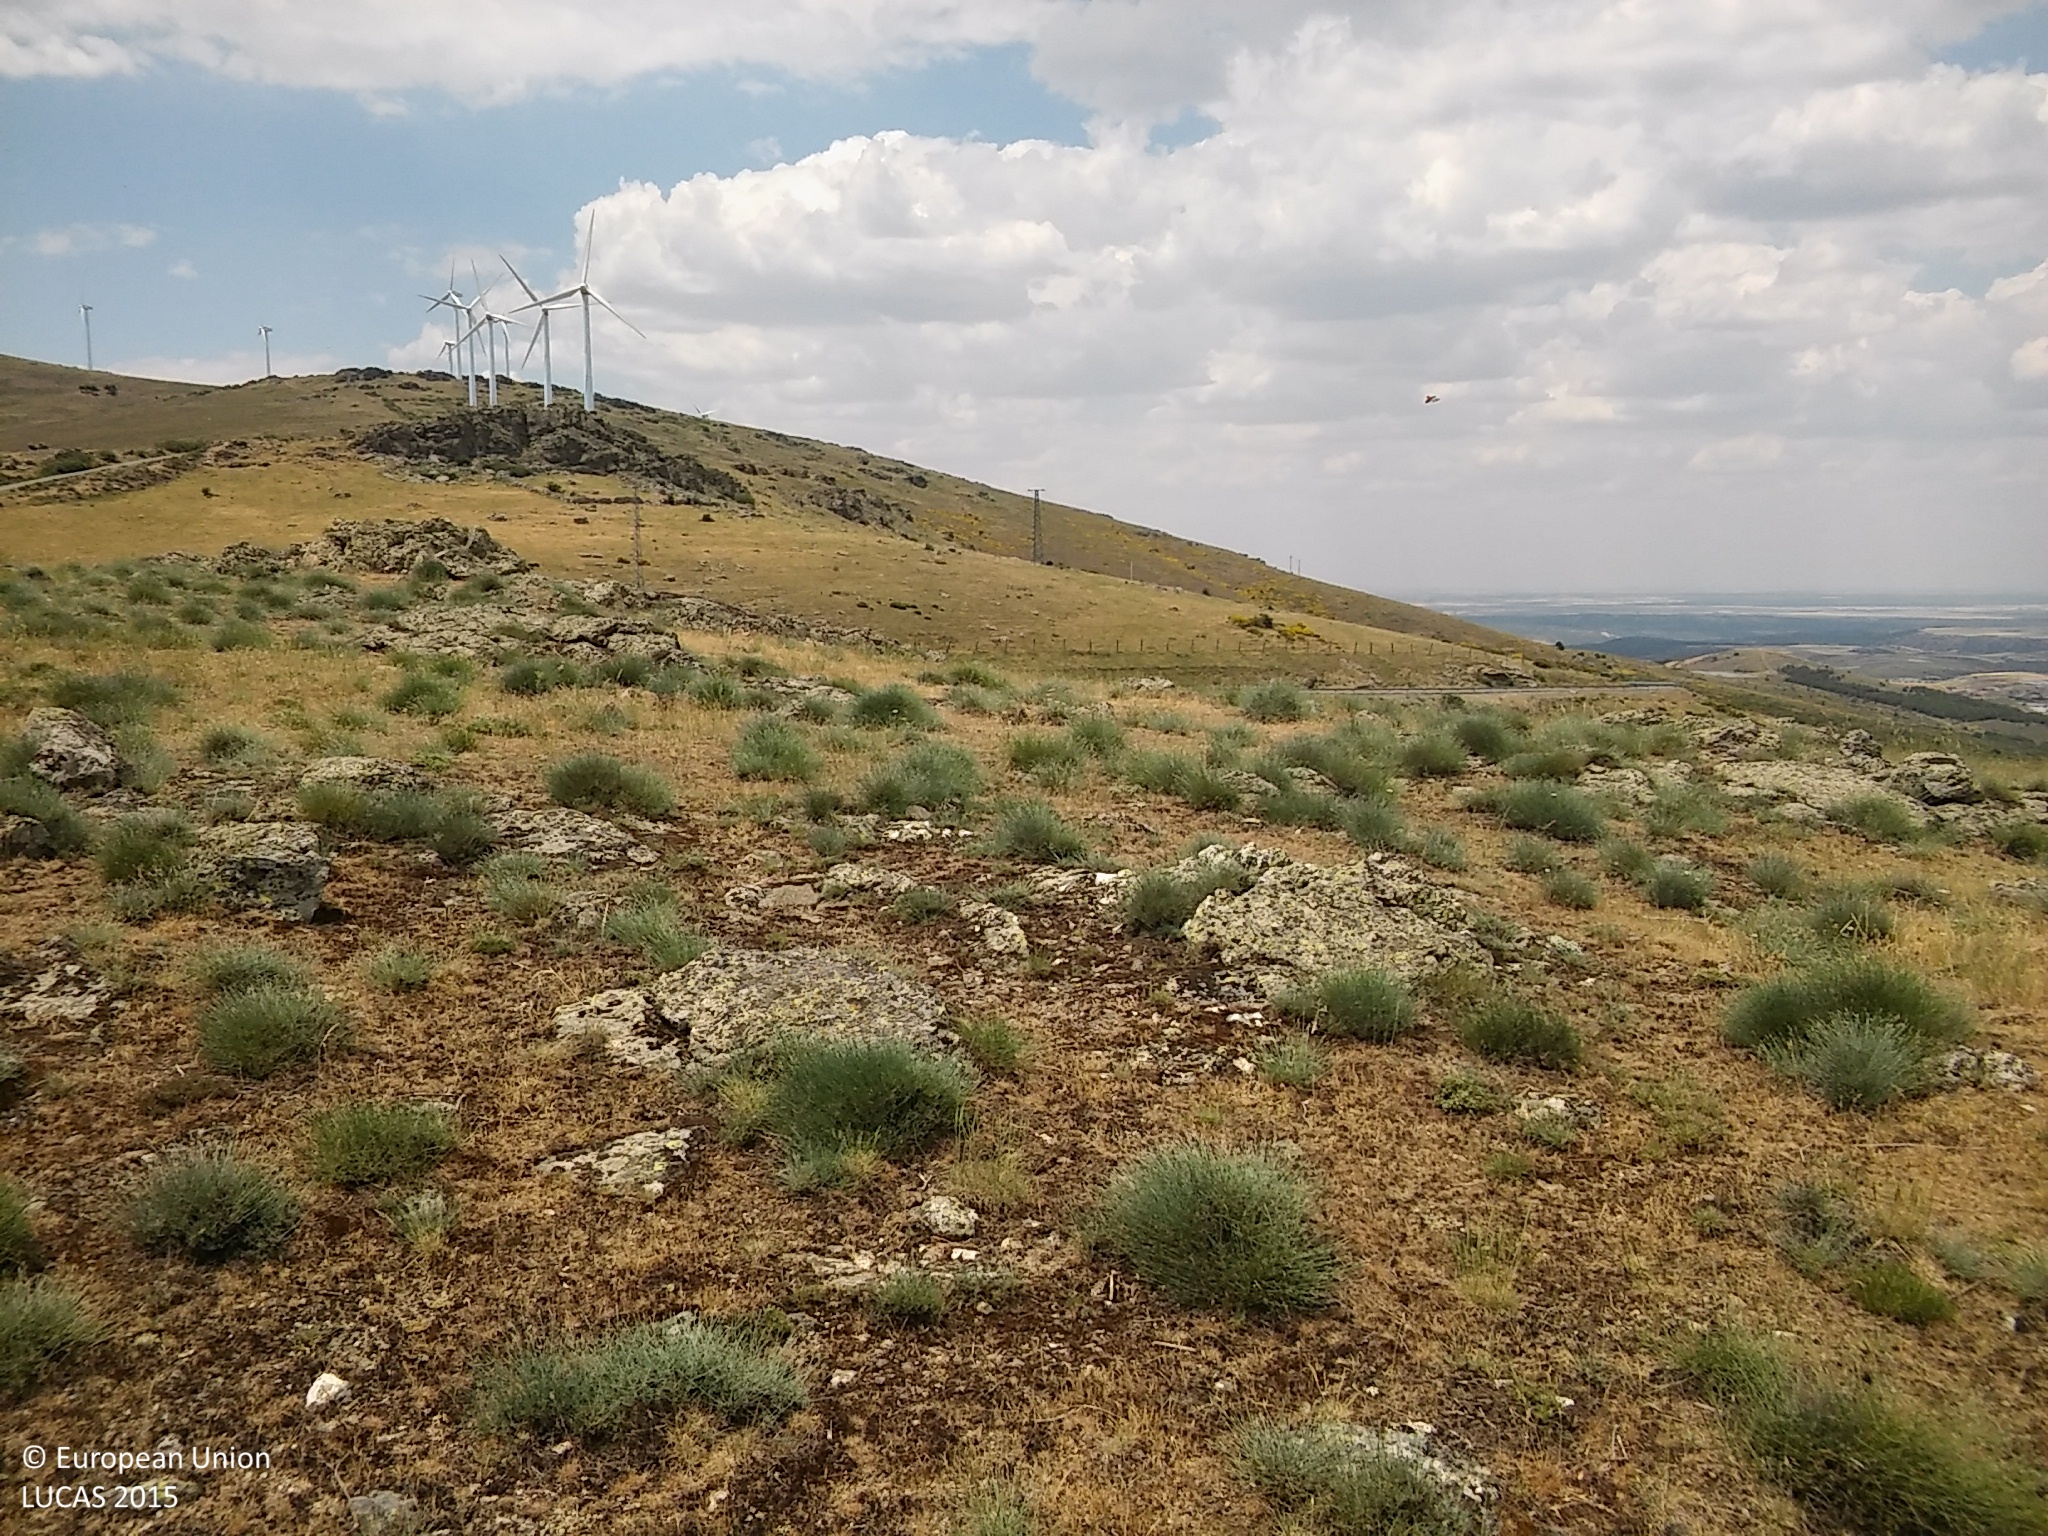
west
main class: Grassland
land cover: Grassland without tree/shrub cover
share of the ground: > 75 %
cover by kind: herbaceous plants 90 %, shrubs 5 %, consolidated bare surface 5 %
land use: Agriculture (excluding fallow land and kitchen gardens)
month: June
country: ES
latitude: 40.7159
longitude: -4.4350
